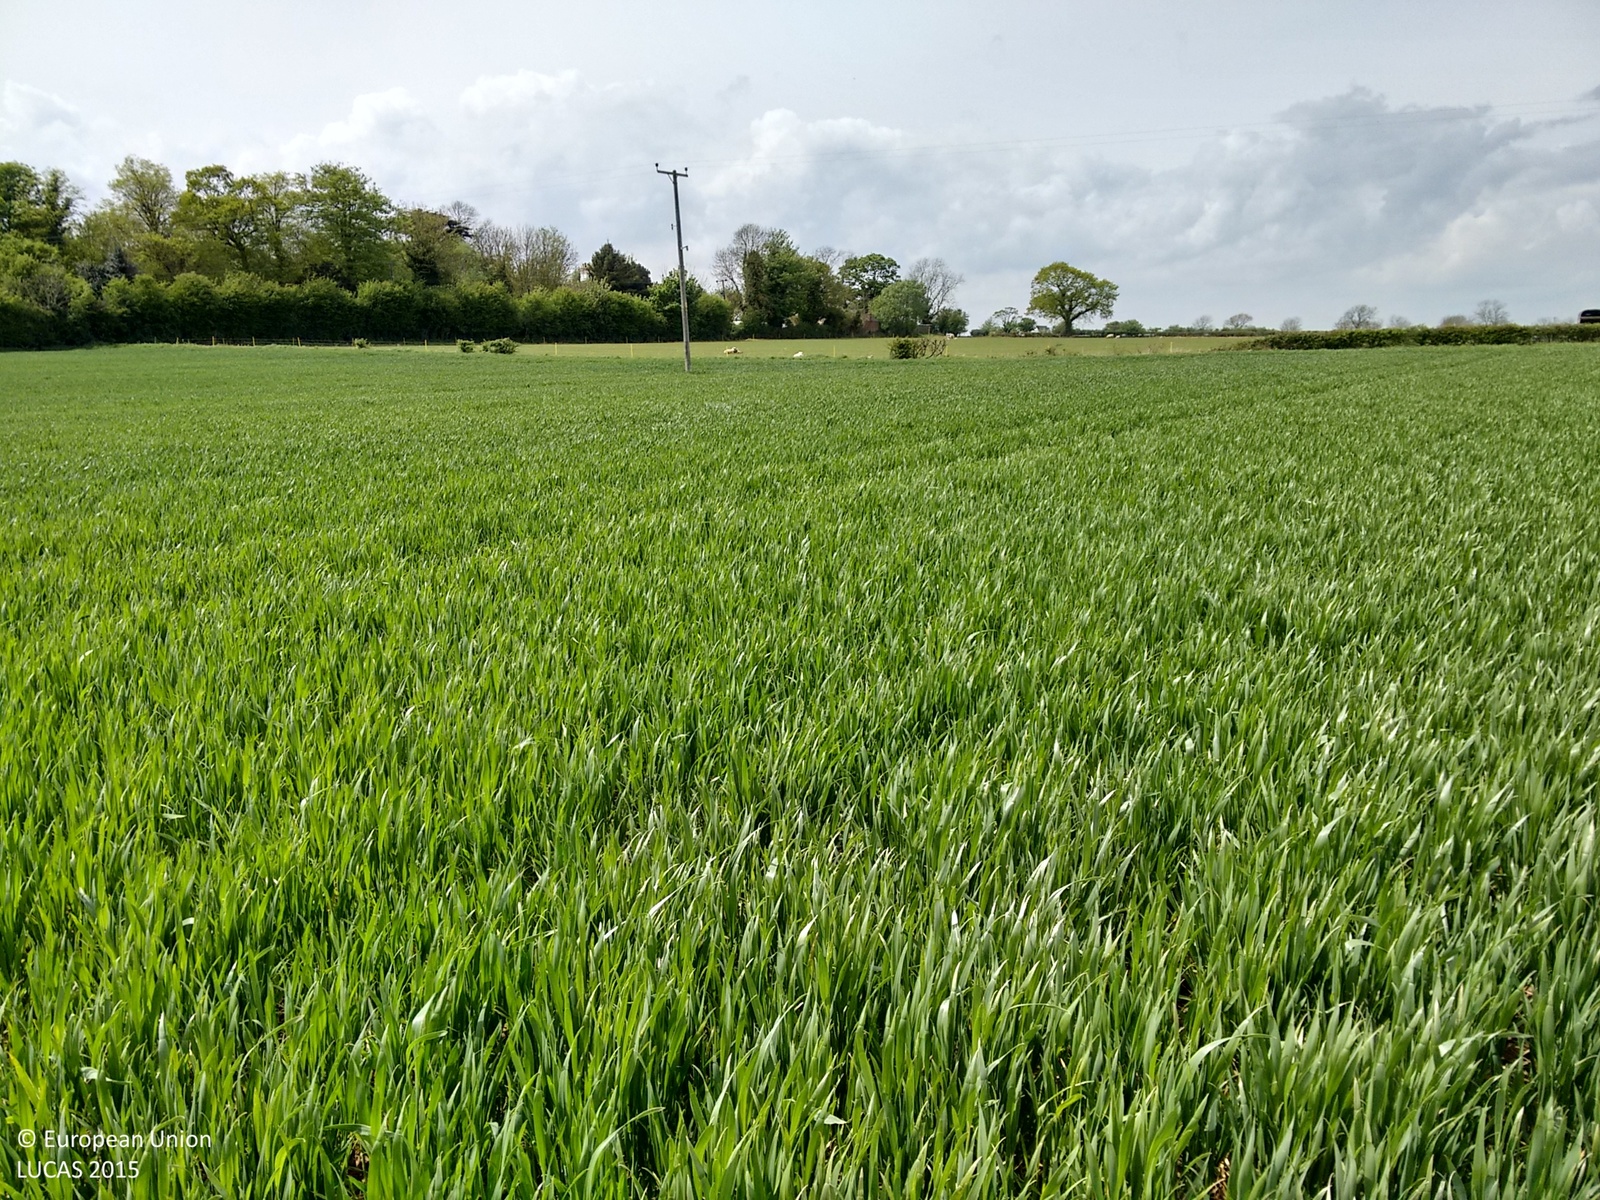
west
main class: Cropland
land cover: Common wheat
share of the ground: > 75 %
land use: Agriculture (excluding fallow land and kitchen gardens)
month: May
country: GB
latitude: 53.3244
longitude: 0.1357
